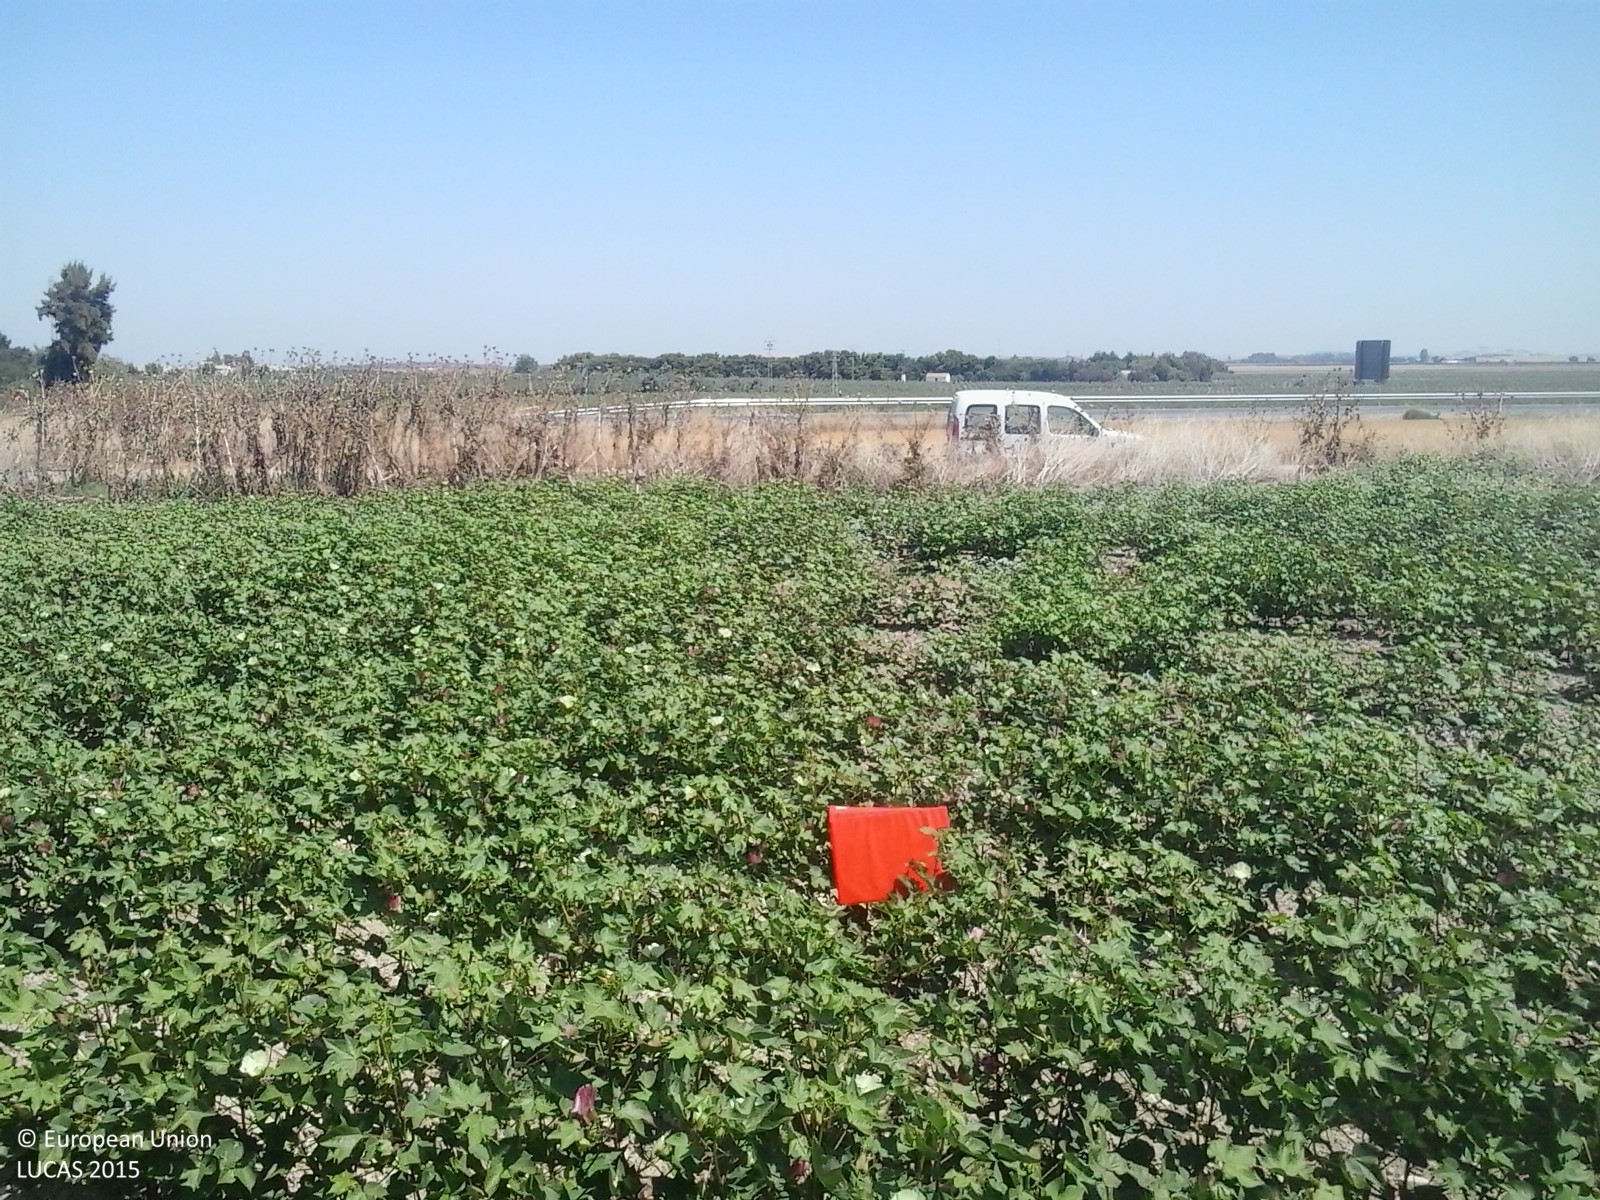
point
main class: Cropland
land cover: Cotton
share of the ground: 50 - 75 %
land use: Agriculture (excluding fallow land and kitchen gardens)
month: July
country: ES
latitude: 36.9024
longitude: -5.9840
